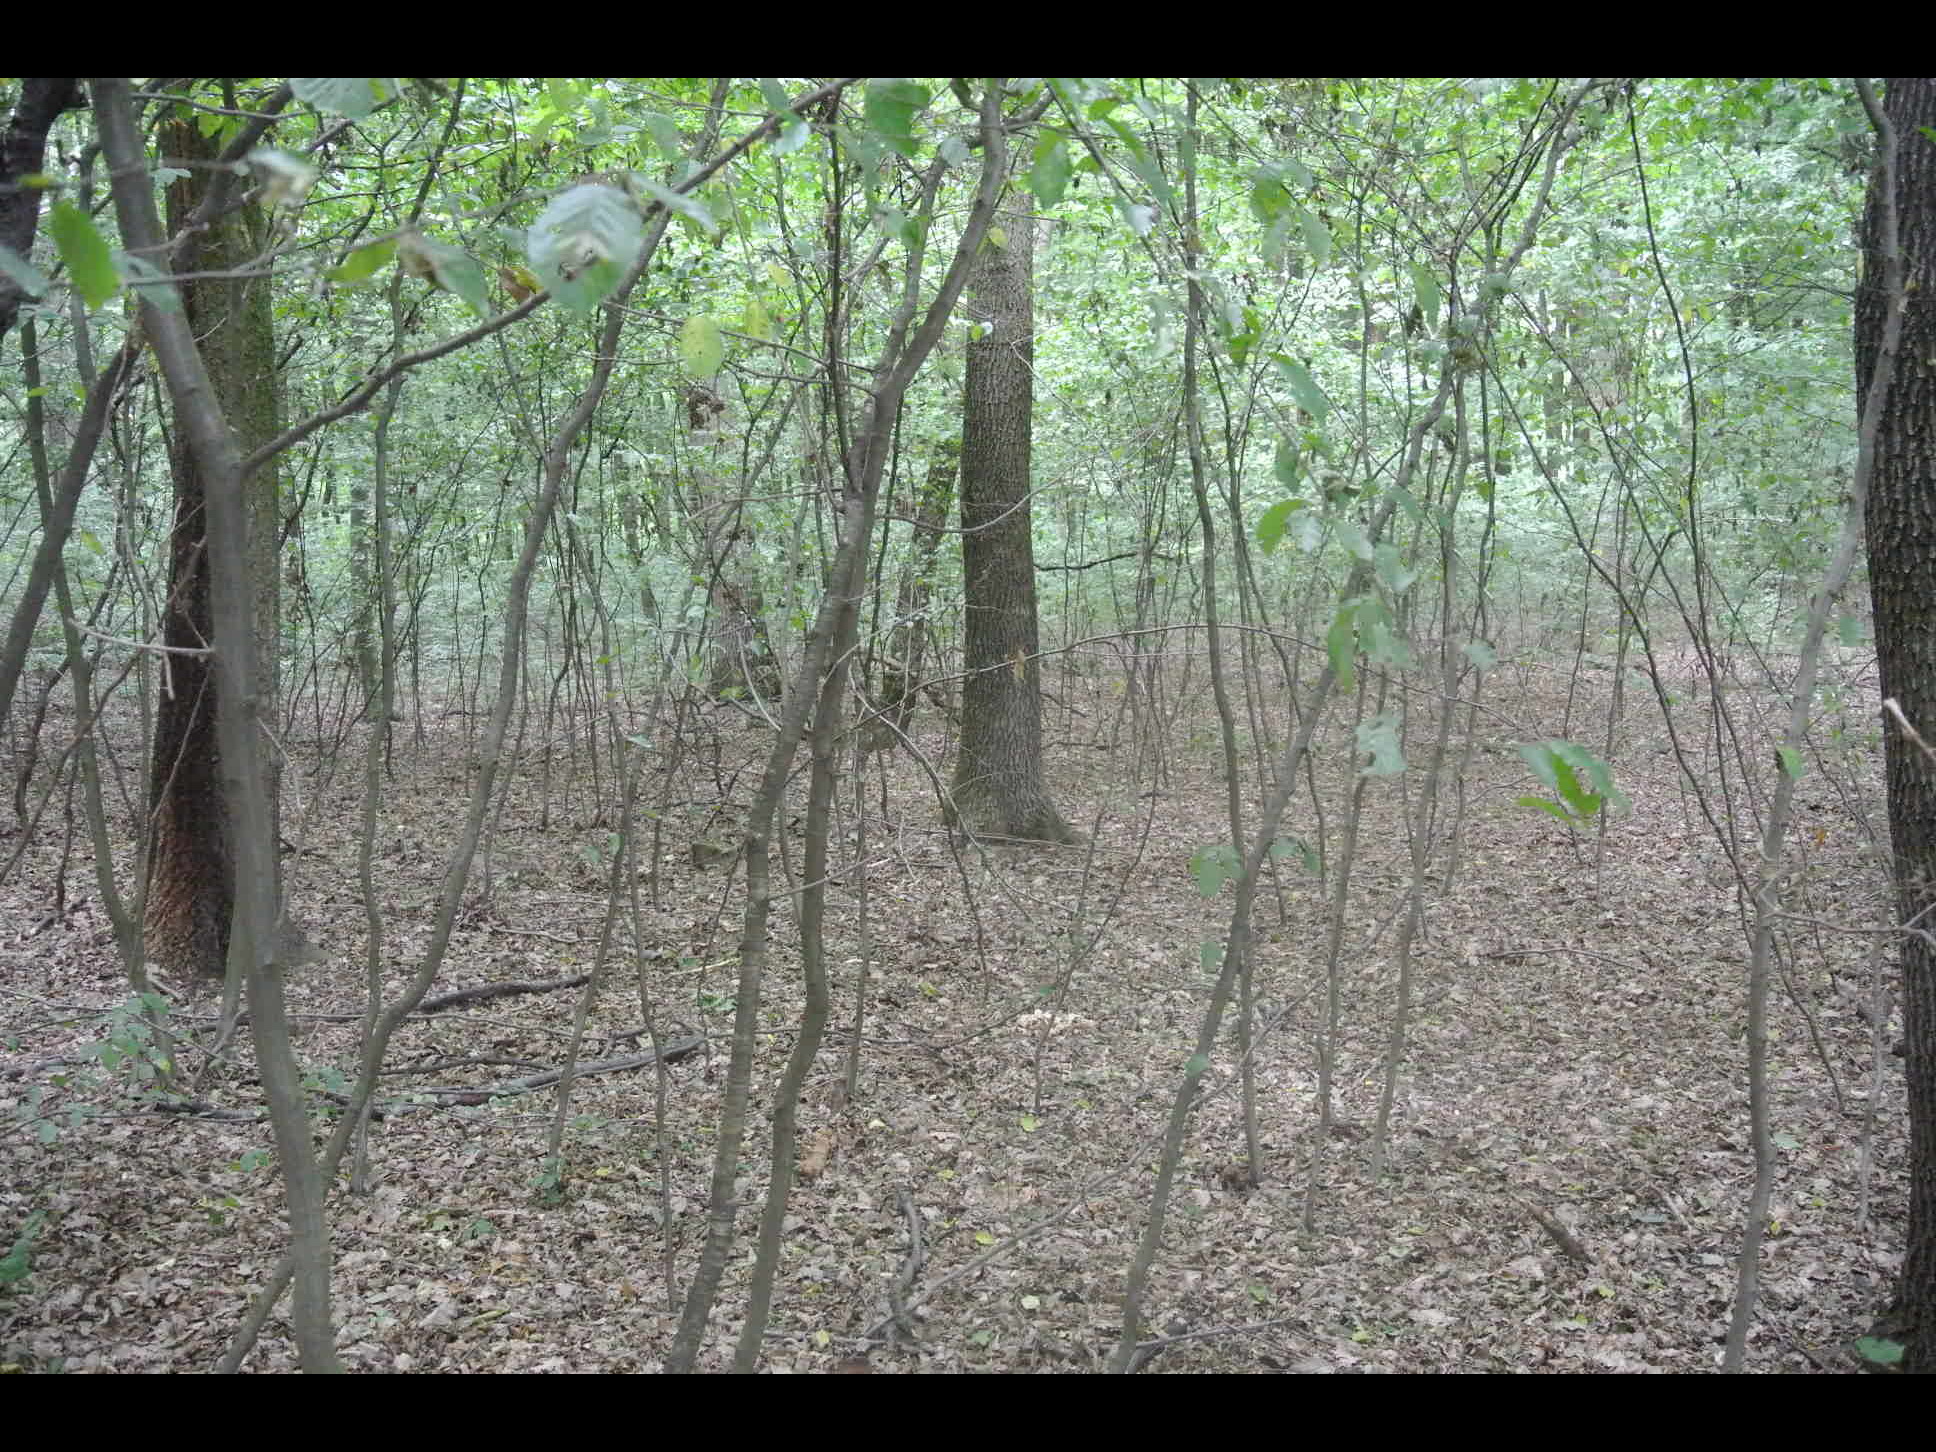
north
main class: Woodland
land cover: Broadleaved woodland
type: beech forest
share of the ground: > 75 %
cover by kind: broadleaved forest trees 100 %
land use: Forestry
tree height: > 5 m
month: July
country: AT
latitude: 47.4661
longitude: 16.5976
